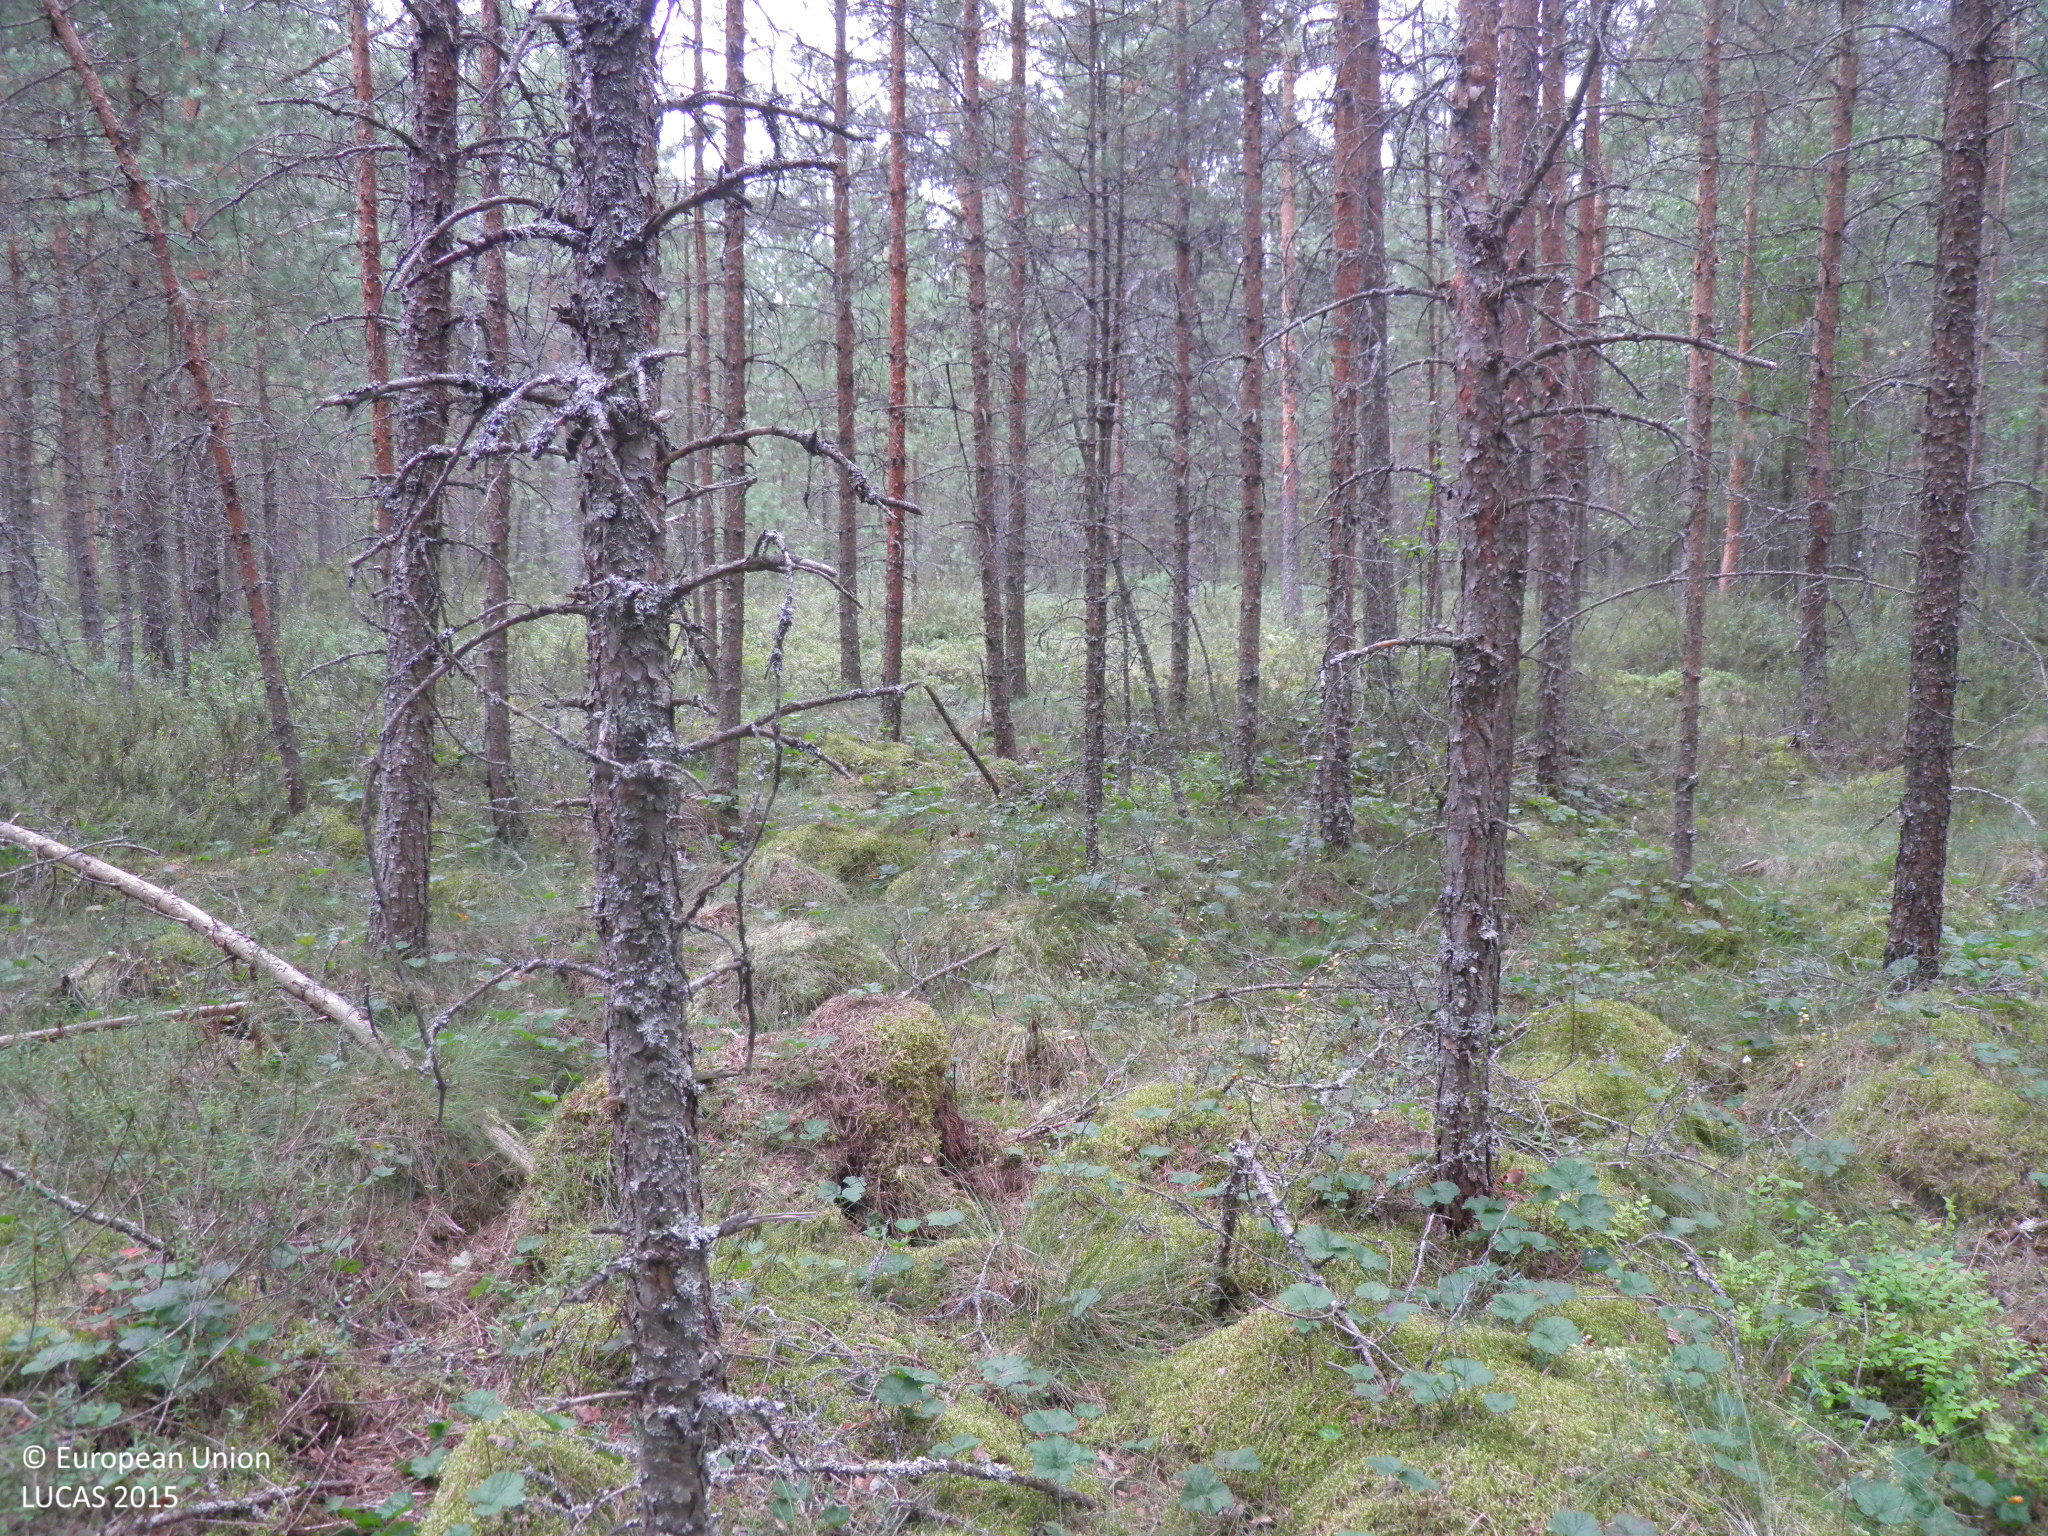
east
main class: Woodland
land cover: Pine dominated coniferous woodland
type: mire and swamp forests
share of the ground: 50 - 75 %
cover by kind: coniferous forest trees 50 %, shrubs 25 %, lichens and mosses 25 %
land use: Forestry
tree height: > 5 m
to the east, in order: Pine dominated coniferous woodland; Ditches and canals; Pine dominated coniferous woodland; Ditches and canals; Pine dominated coniferous woodland; Ditches and canals; Pine dominated coniferous woodland
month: August
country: FI
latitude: 61.0617
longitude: 22.9495
